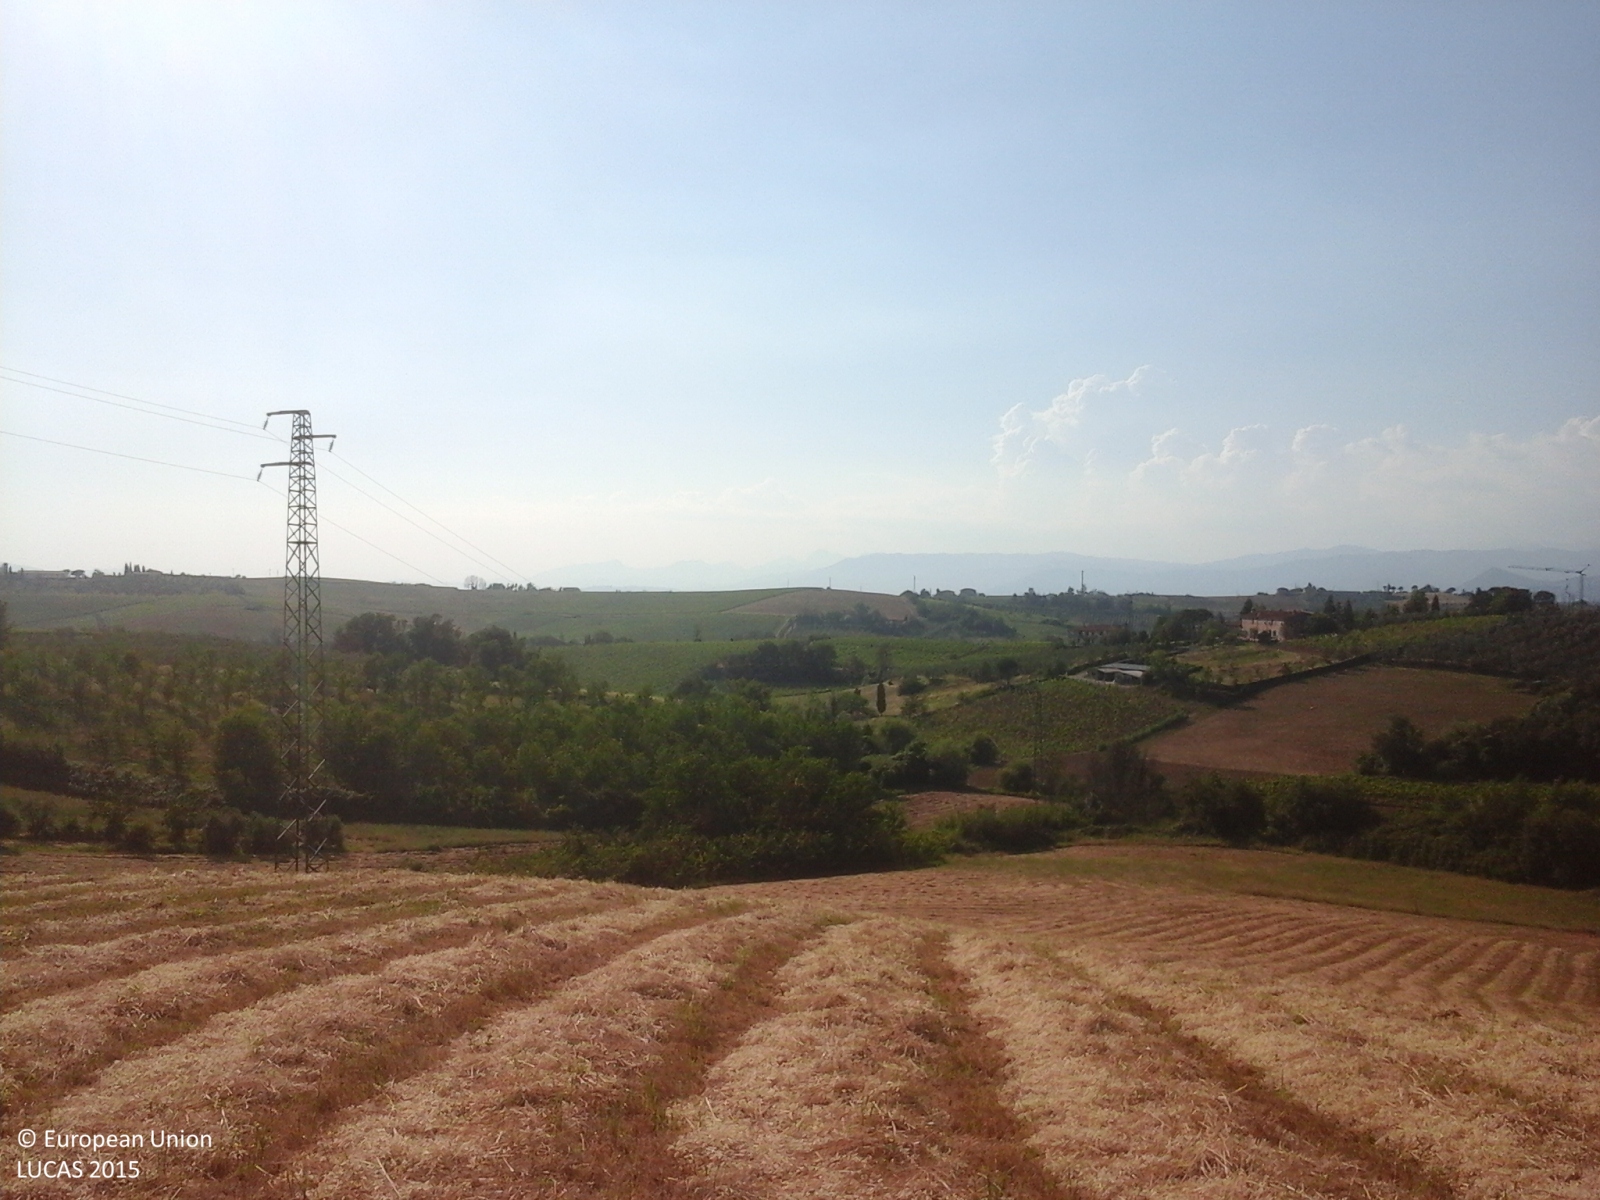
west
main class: Cropland
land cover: Mixed cereals for fodder
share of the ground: > 75 %
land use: Agriculture (excluding fallow land and kitchen gardens)
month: June
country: IT
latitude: 43.7691
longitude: 10.9293
